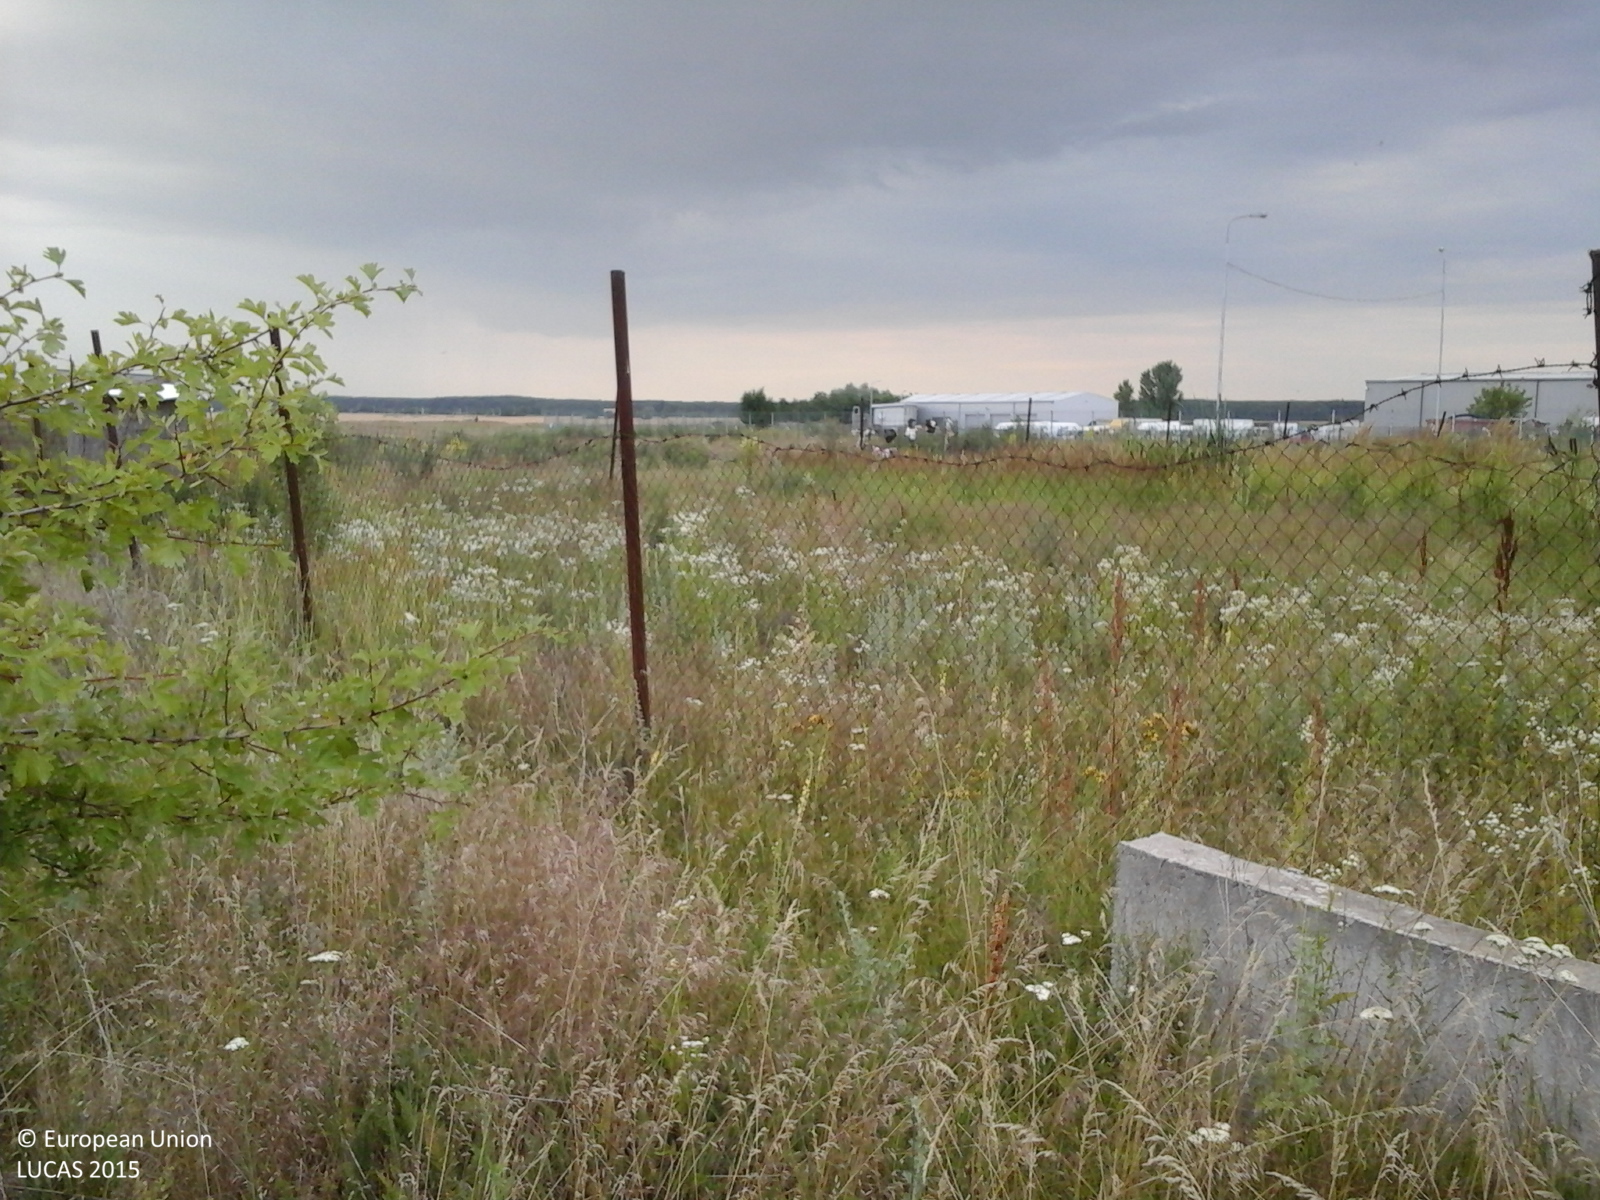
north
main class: Grassland
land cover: Spontaneously vegetated surfaces
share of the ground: > 75 %
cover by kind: herbaceous plants 100 %
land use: Fallow land
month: June
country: RO
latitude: 44.4541
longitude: 26.2579
